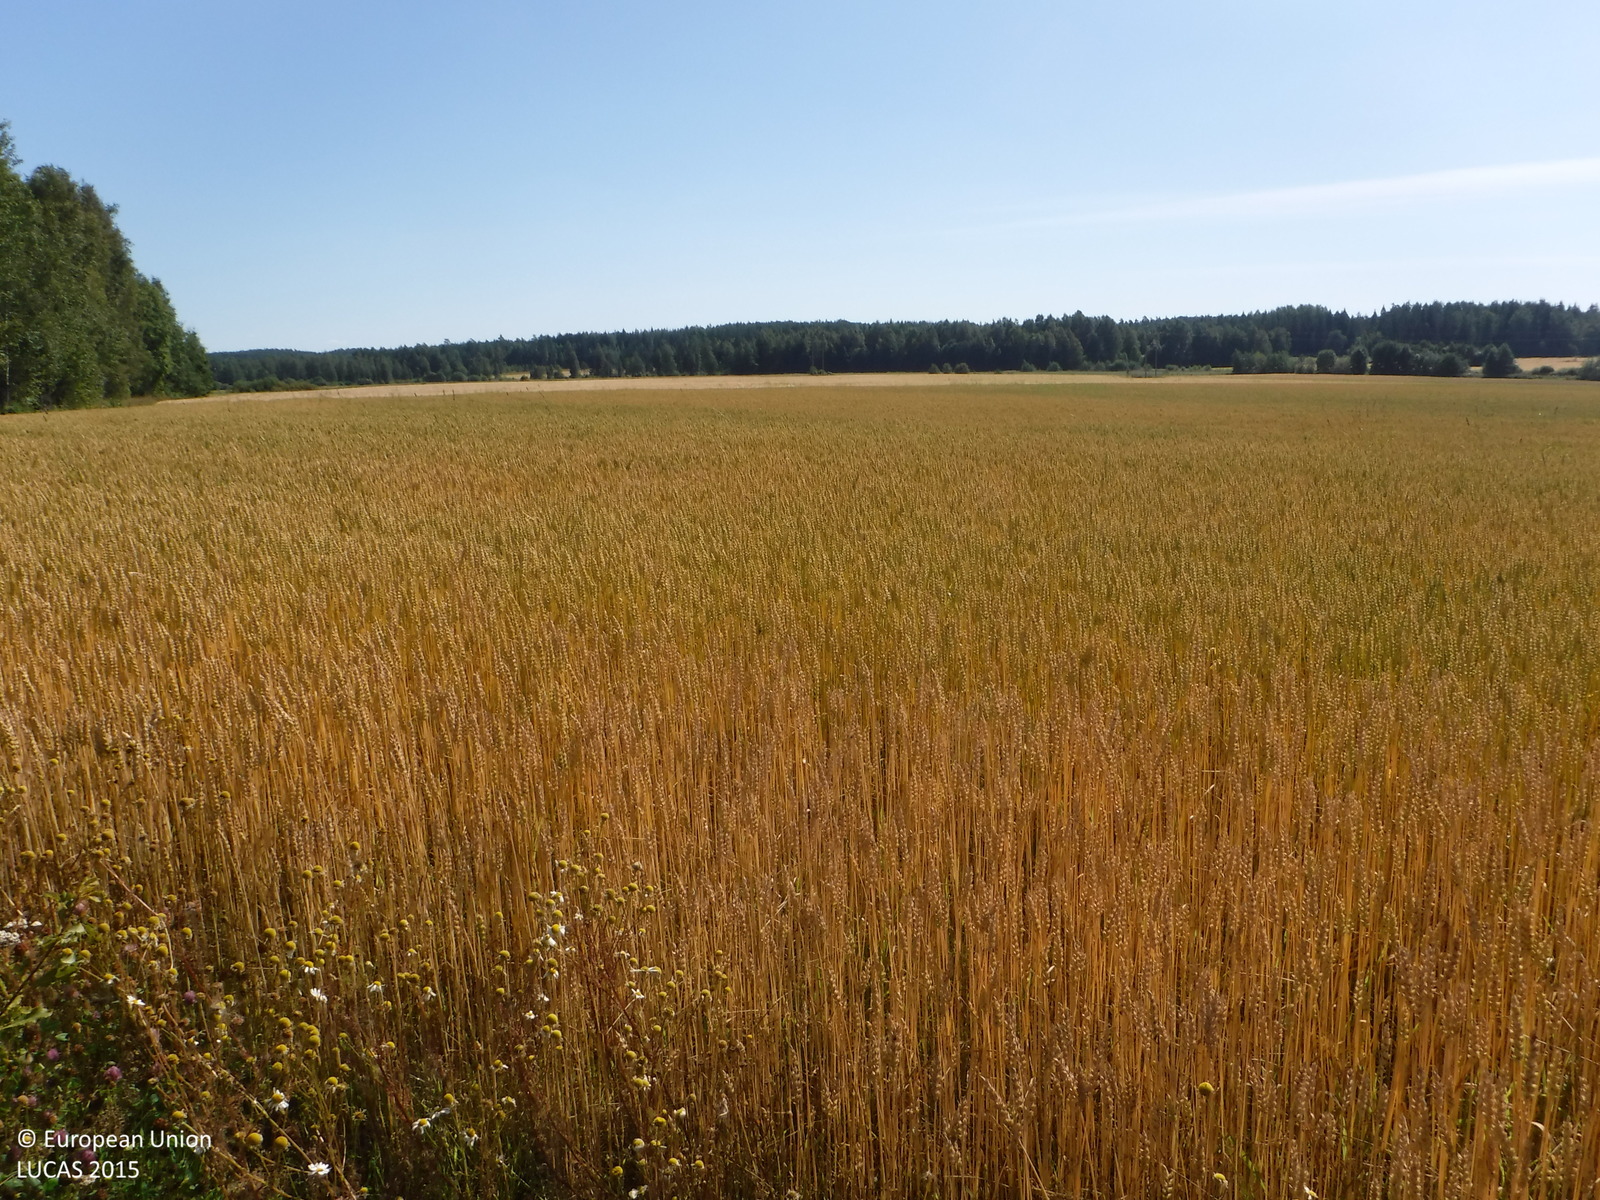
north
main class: Cropland
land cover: Common wheat
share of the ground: > 75 %
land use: Agriculture (excluding fallow land and kitchen gardens)
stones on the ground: < 10 %
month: August
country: FI
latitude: 61.1000
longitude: 21.8734
